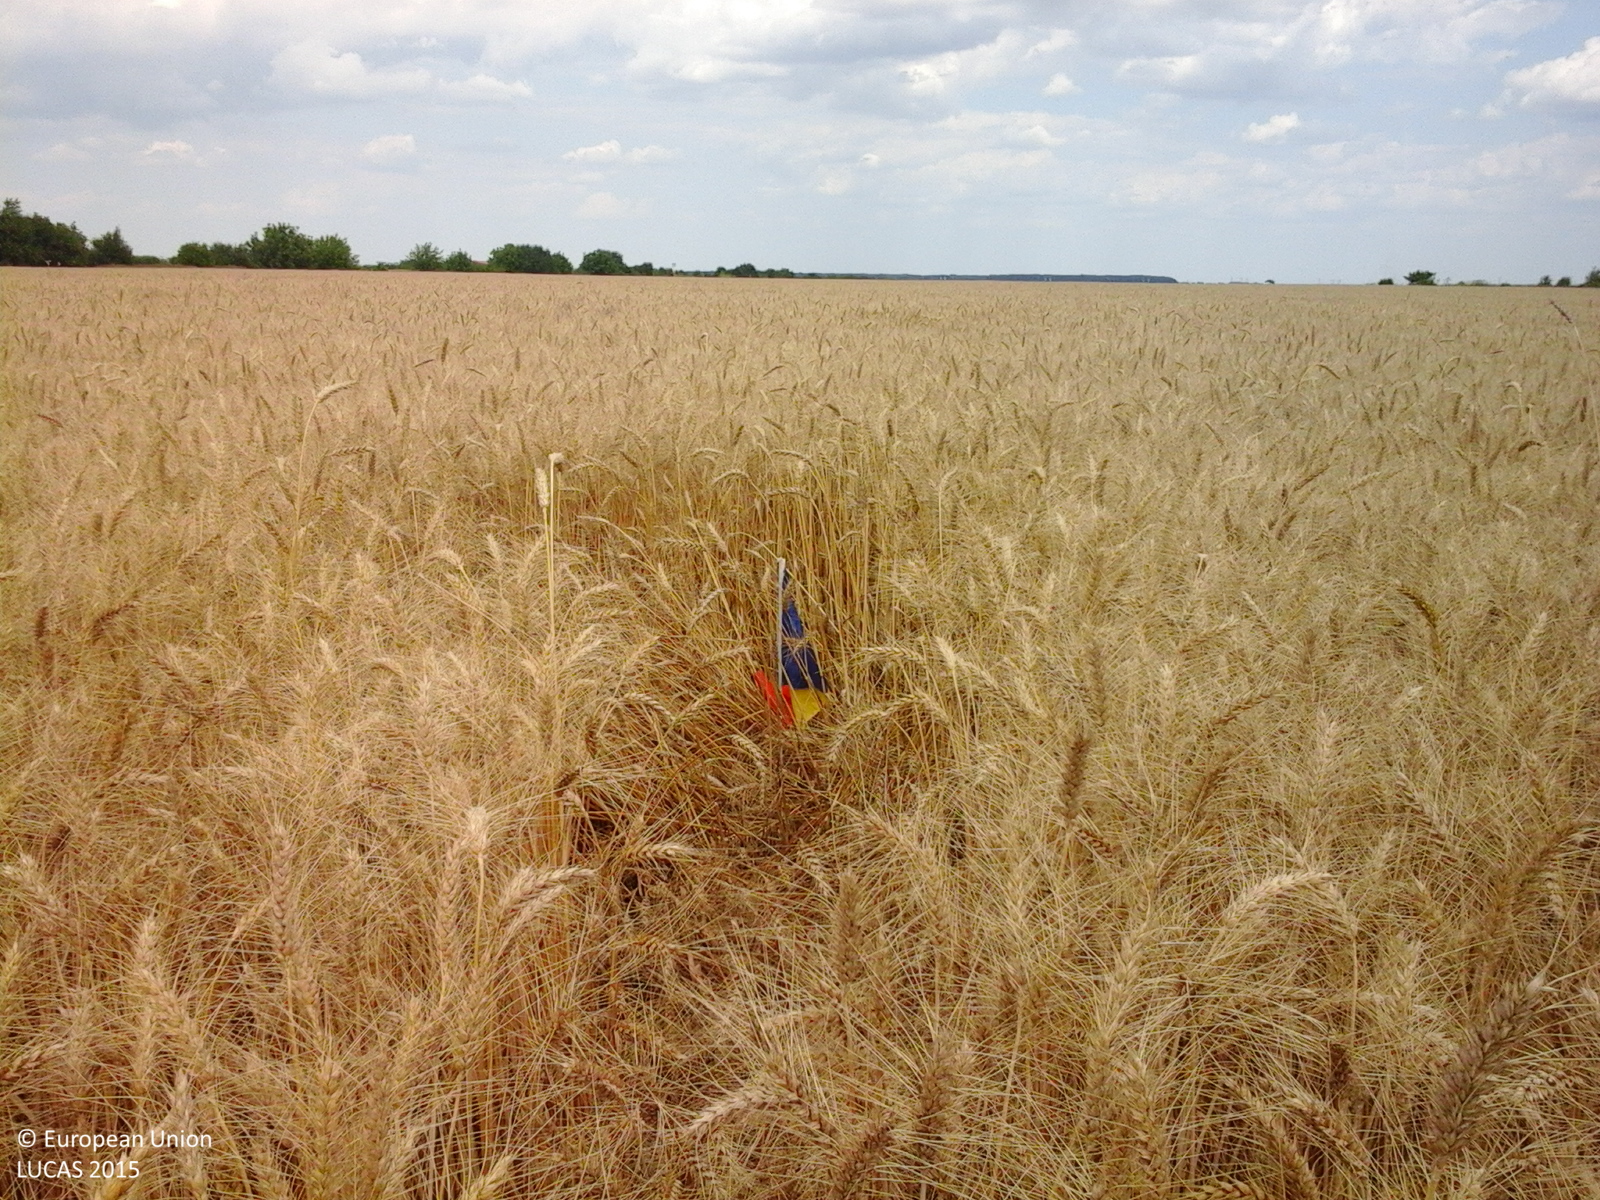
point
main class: Cropland
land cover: Common wheat
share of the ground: > 75 %
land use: Agriculture (excluding fallow land and kitchen gardens)
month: June
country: RO
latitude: 44.5651
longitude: 26.1356
